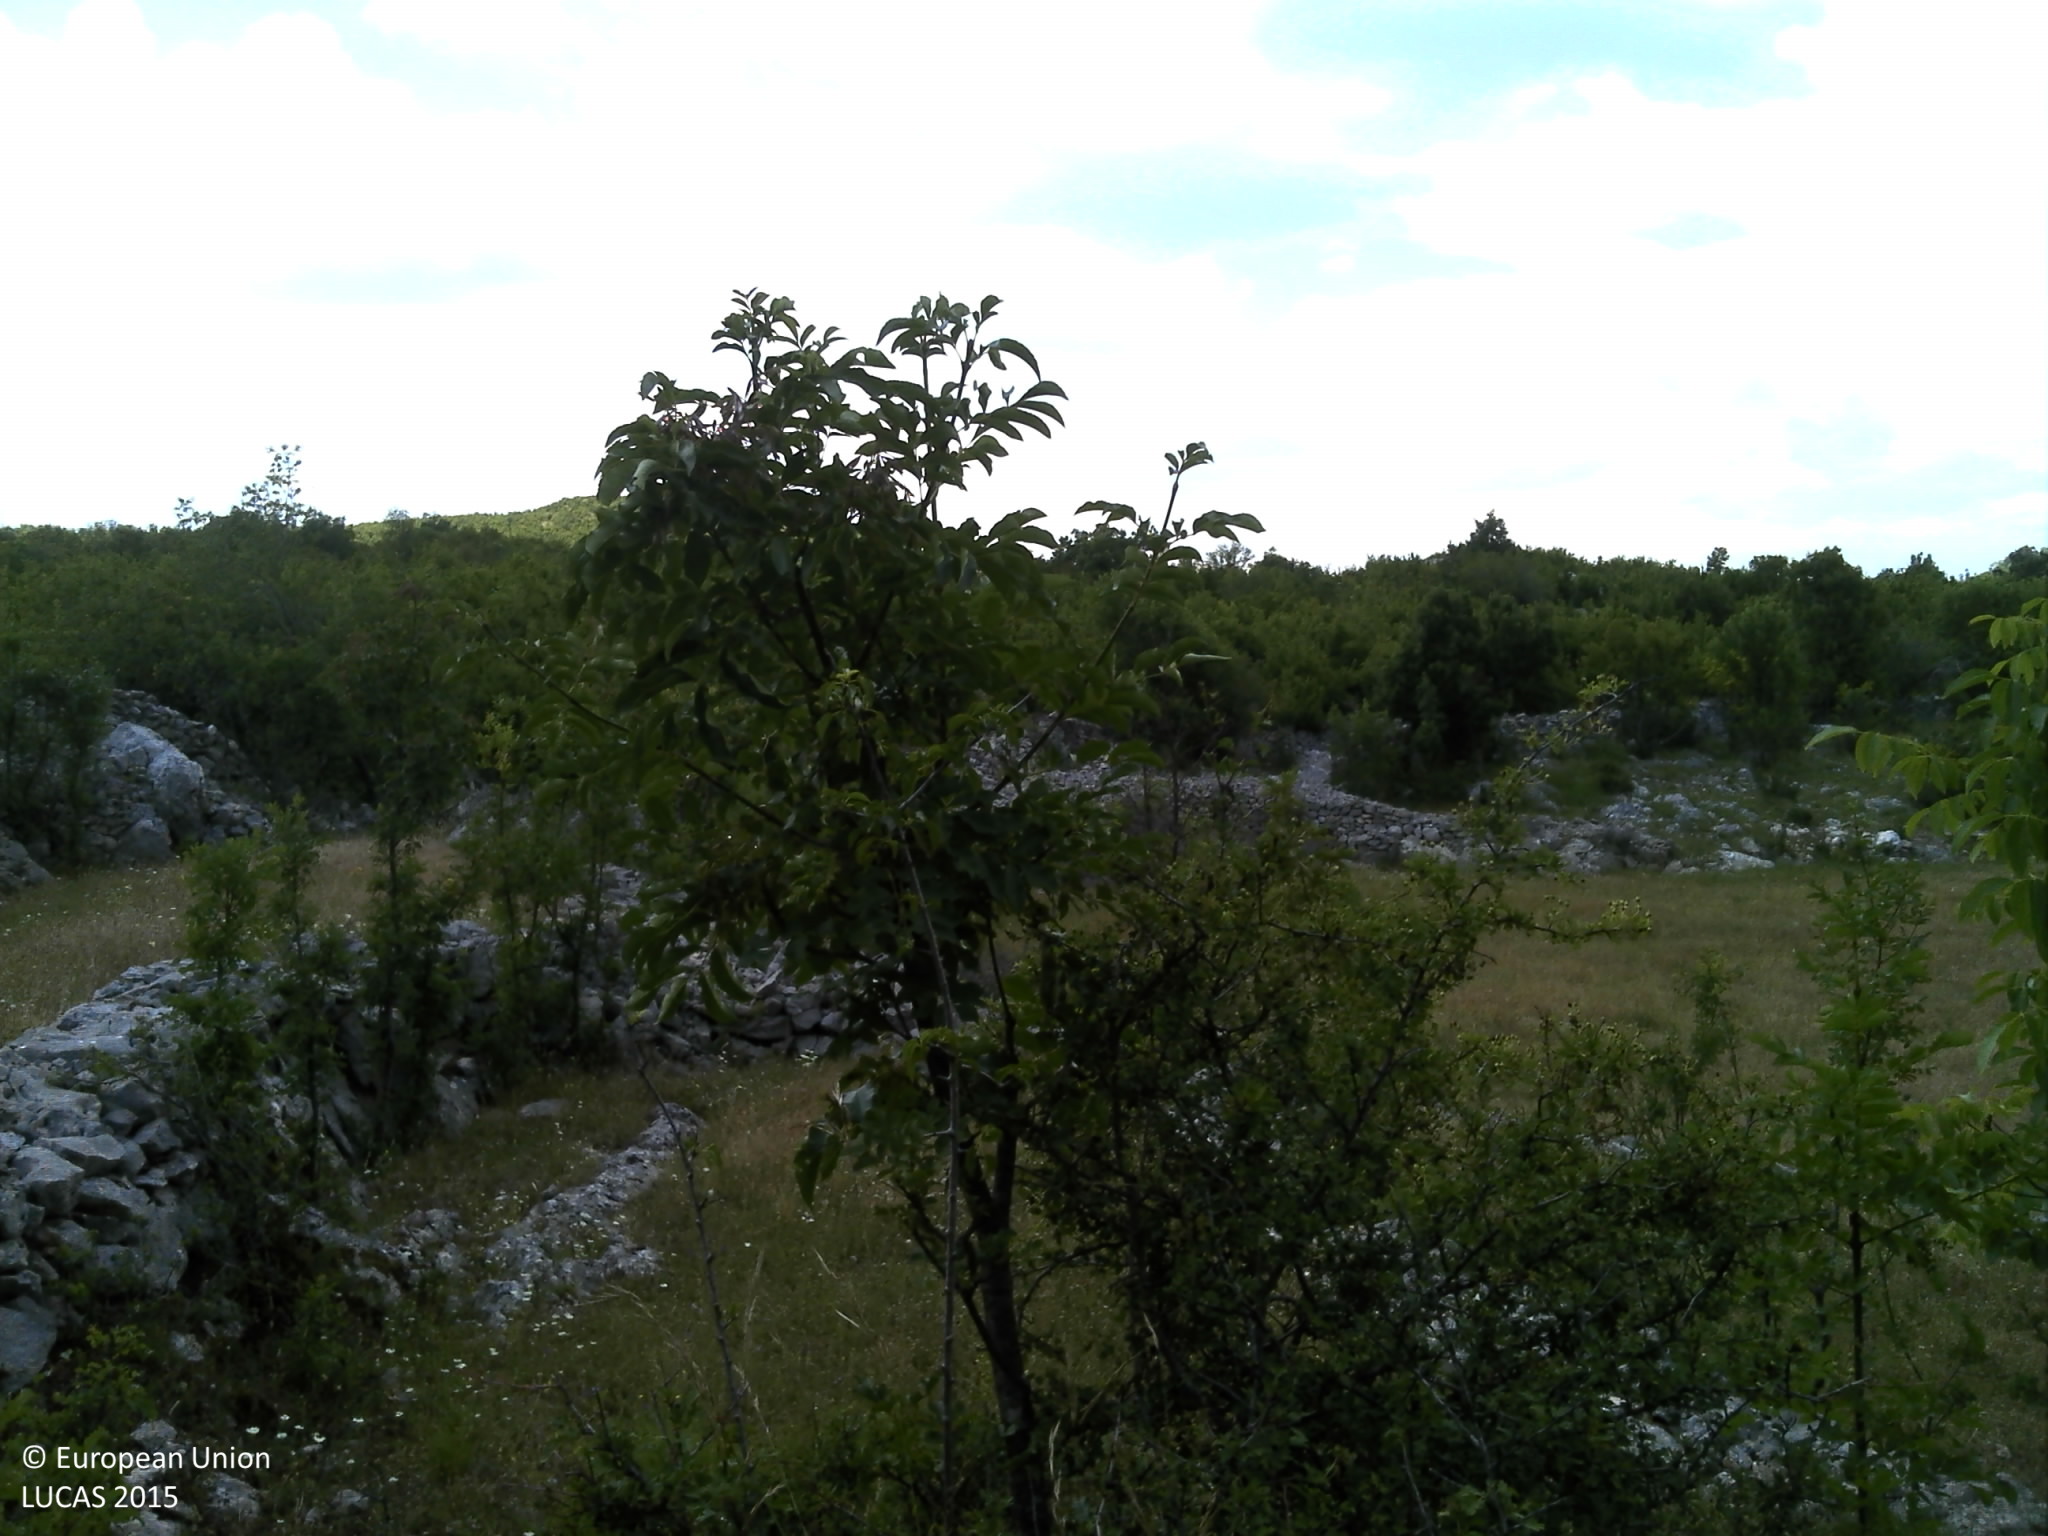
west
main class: Grassland
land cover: Grassland with sparse tree/shrub cover
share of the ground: 50 - 75 %
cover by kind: herbaceous plants 60 %, consolidated bare surface 20 %, unconsolidated bare surface 10 %, broadleaved forest trees 5 %, shrubs 5 %
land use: Abandoned areas
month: June
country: HR
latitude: 43.7079
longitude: 16.2833
